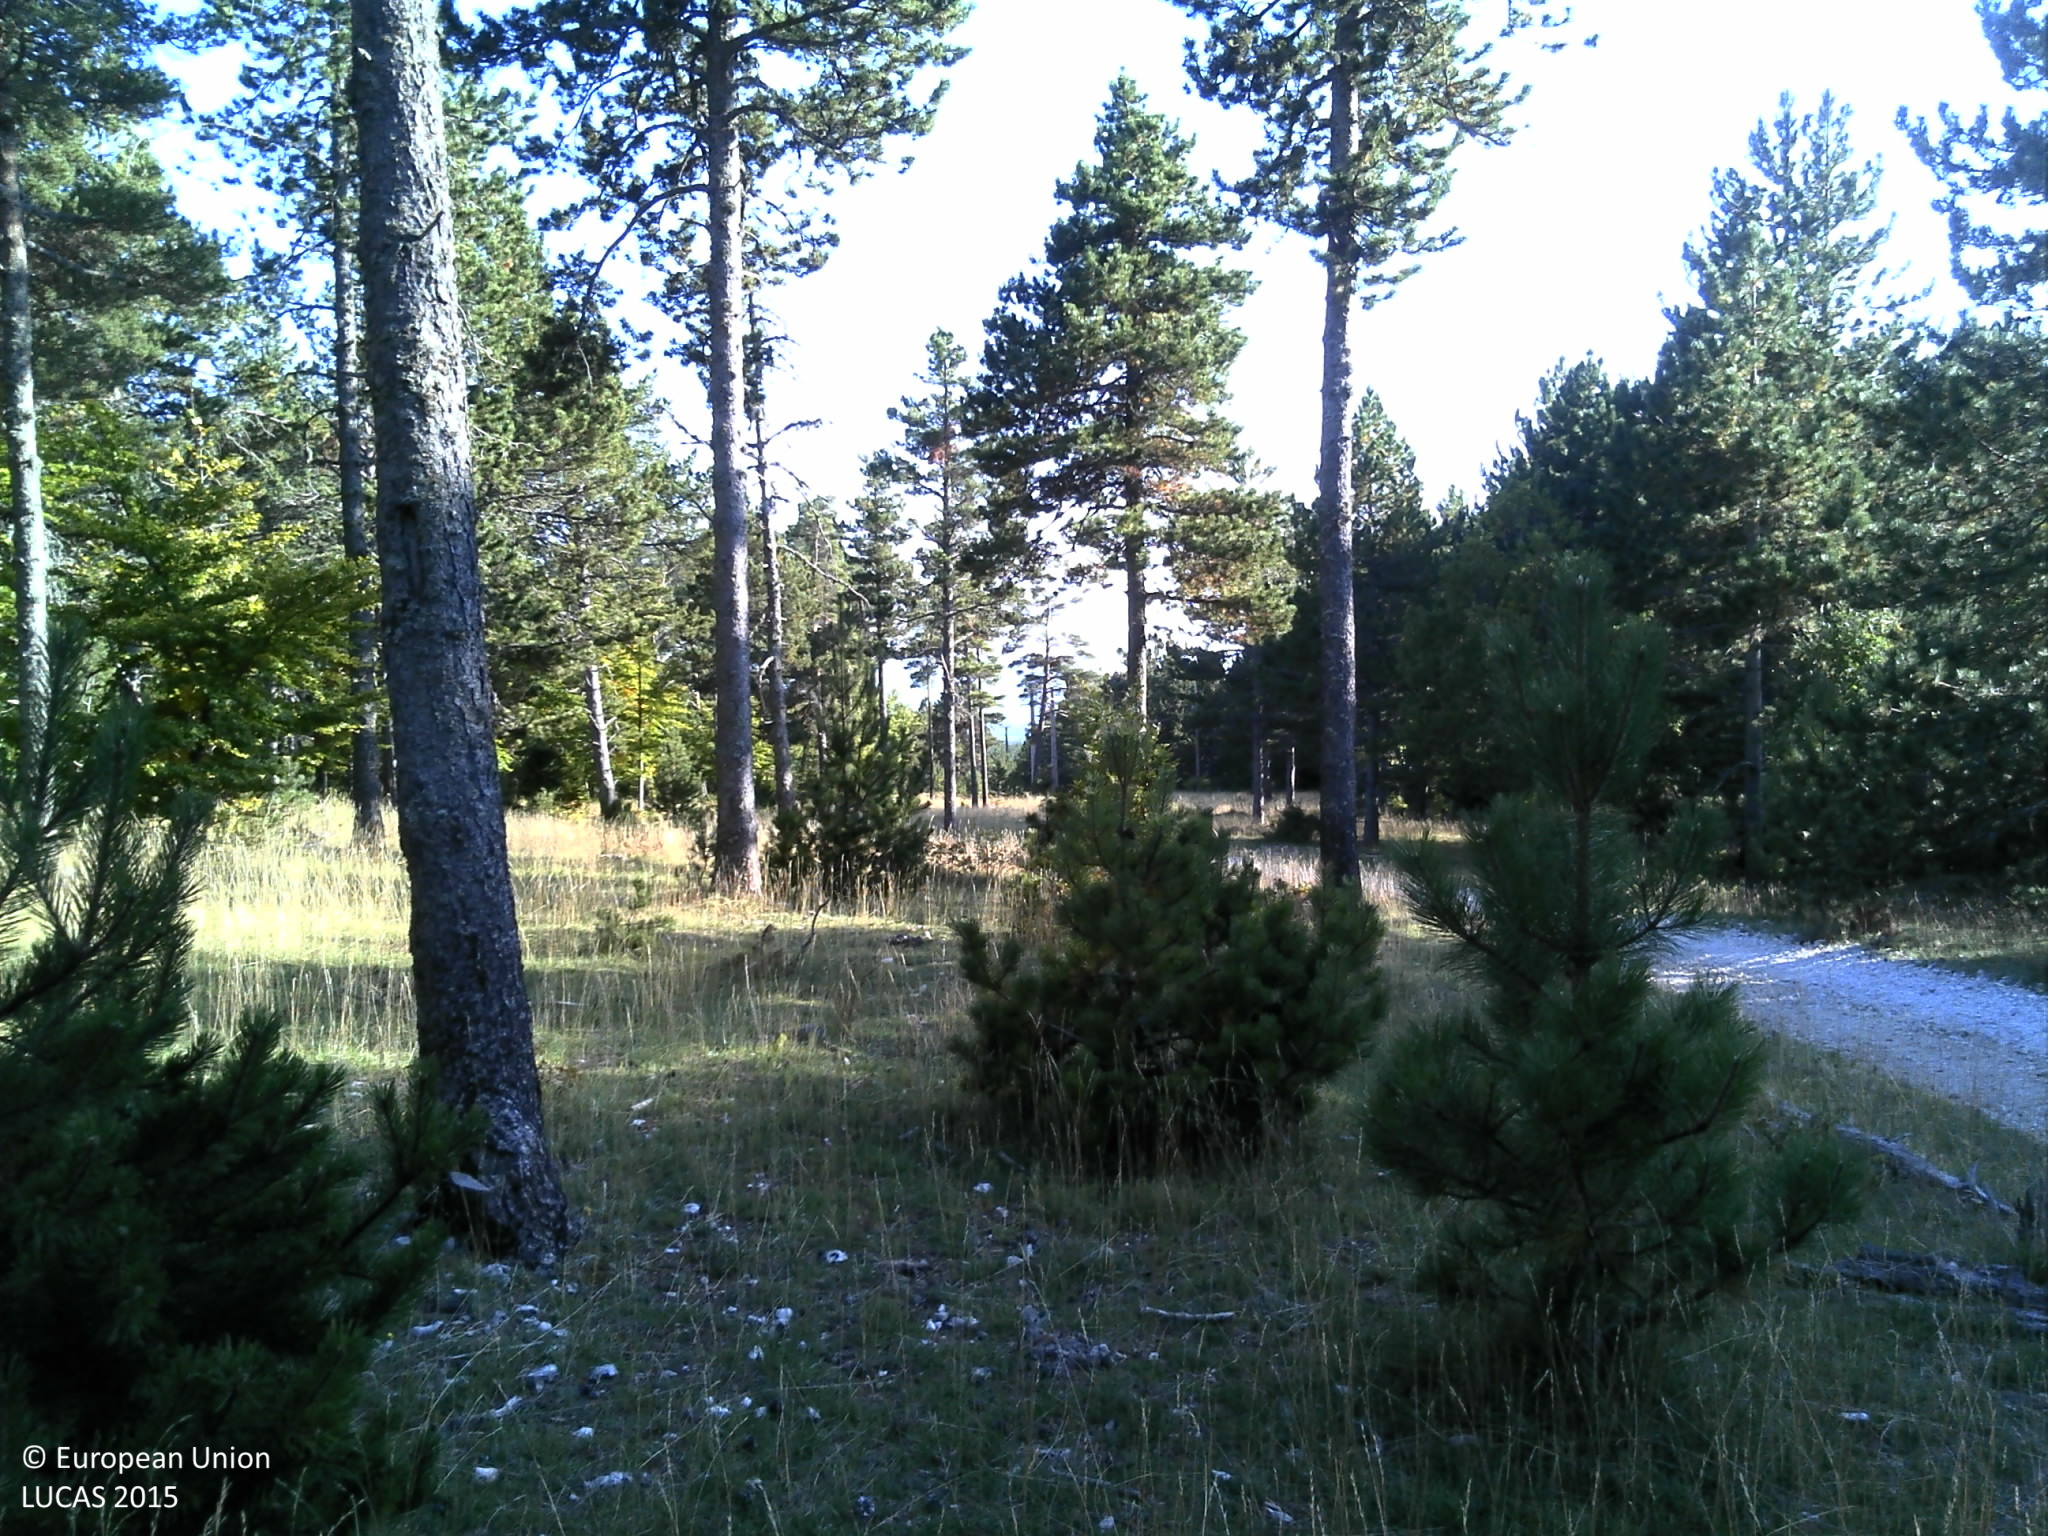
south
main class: Woodland
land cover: Other coniferous woodland
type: alpine coniferous forest
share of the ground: > 75 %
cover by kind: coniferous forest trees 70 %, herbaceous plants 30 %
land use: Forestry
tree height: > 5 m
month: September
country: FR
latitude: 44.1378
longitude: 5.3456
